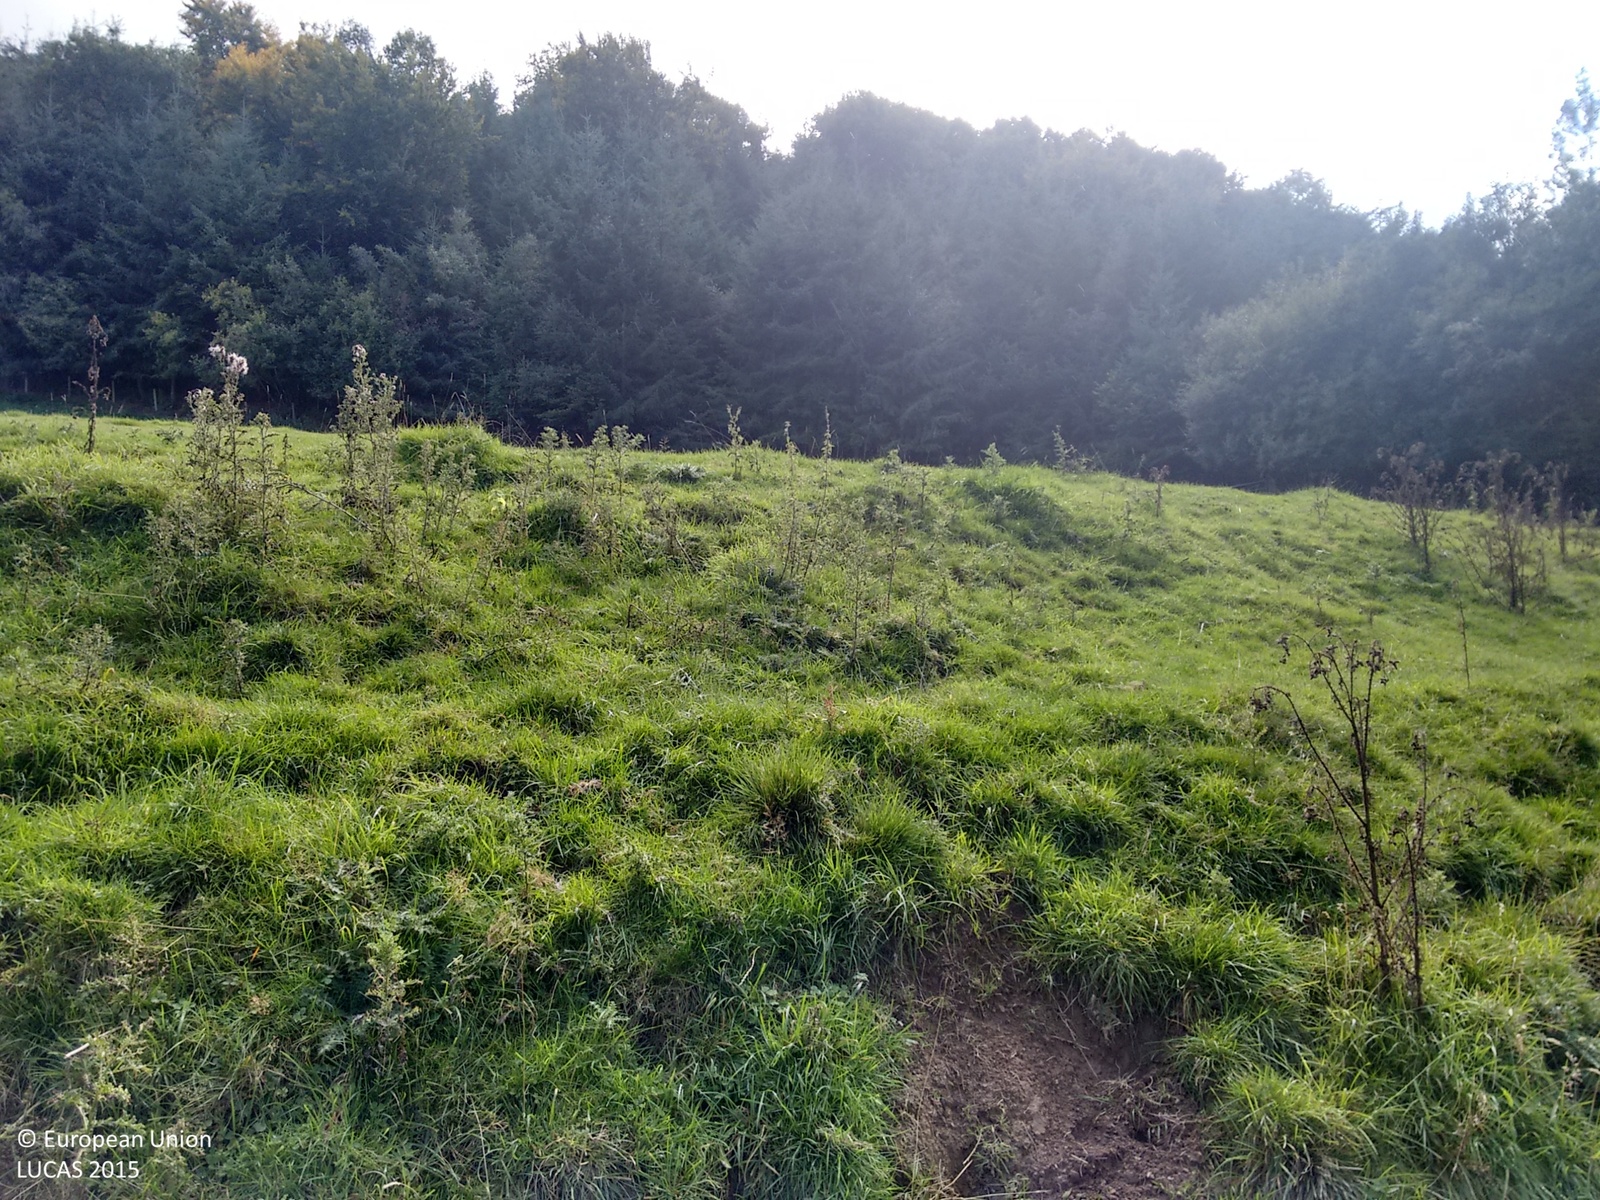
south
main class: Grassland
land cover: Grassland without tree/shrub cover
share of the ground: > 75 %
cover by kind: herbaceous plants 100 %
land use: Agriculture (excluding fallow land and kitchen gardens)
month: September
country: GB
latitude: 52.5952
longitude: -3.2629
